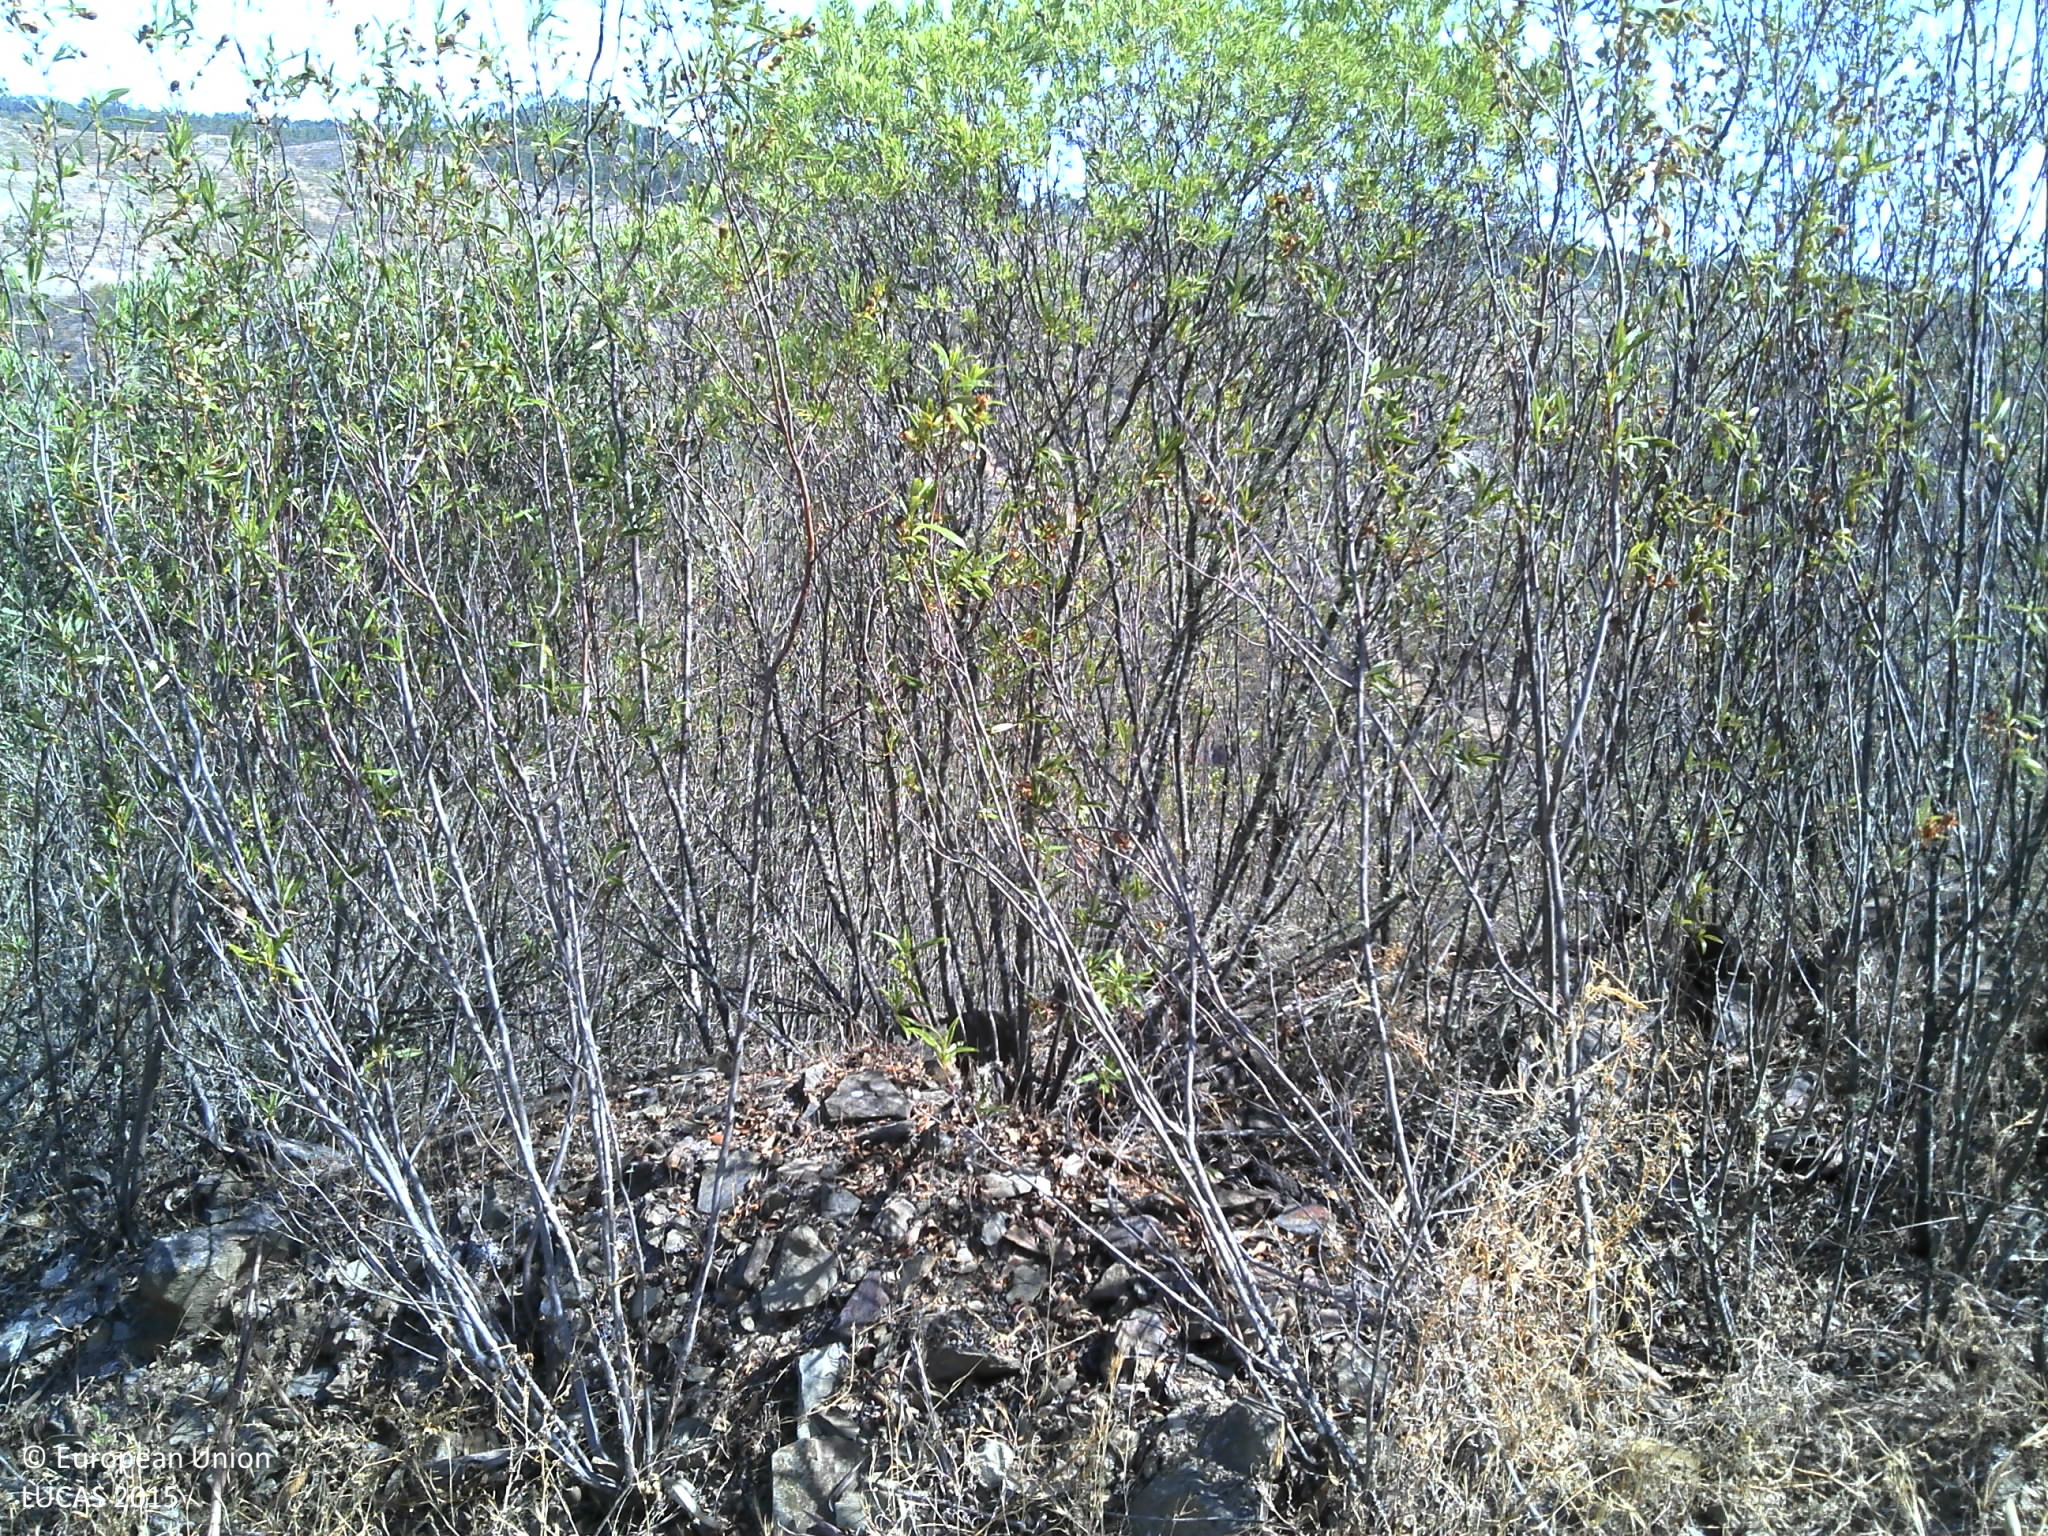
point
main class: Shrubland
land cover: Shrubland without tree cover
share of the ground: 50 - 75 %
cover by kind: shrubs 75 %, unconsolidated bare surface 25 %
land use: Semi-natural and natural areas not in use
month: July
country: PT
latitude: 39.4877
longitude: -7.9277
